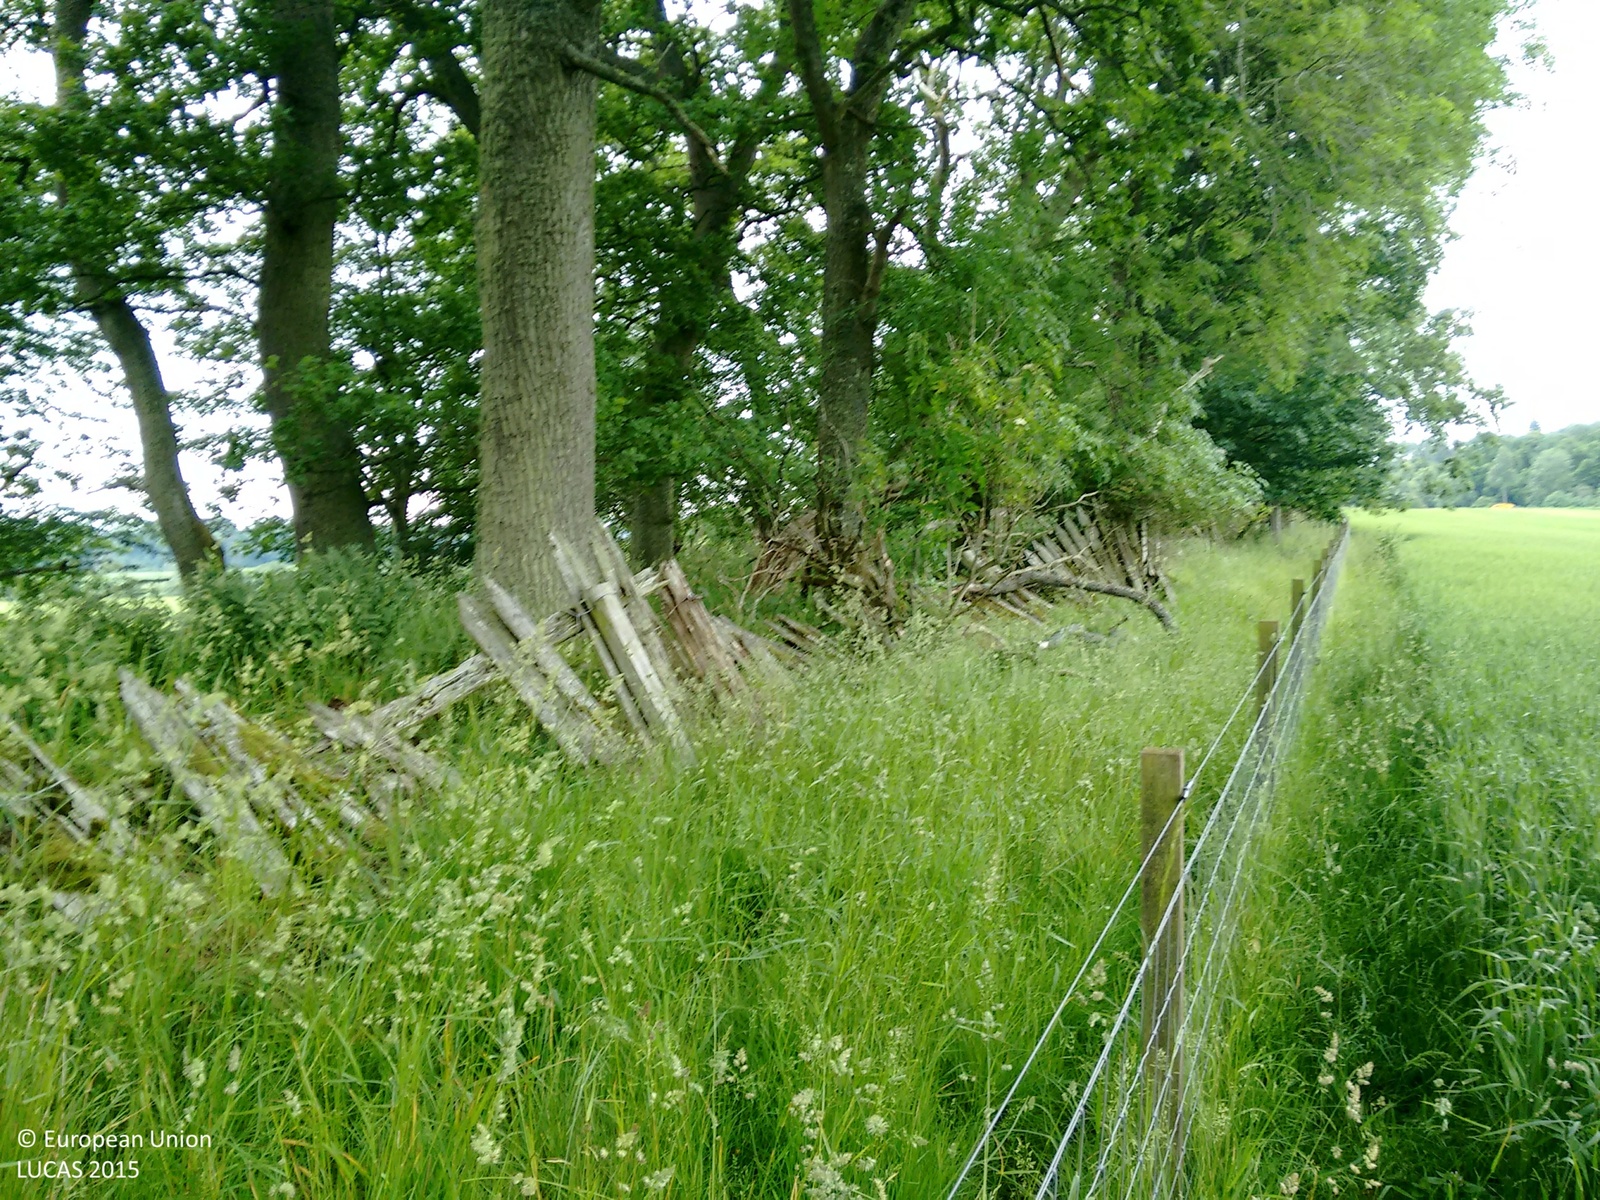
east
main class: Woodland
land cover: Broadleaved woodland
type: mesophytic deciduous forest
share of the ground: > 75 %
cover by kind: broadleaved forest trees 100 %
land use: Agriculture (excluding fallow land and kitchen gardens)
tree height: > 5 m
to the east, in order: Fences; Dry stone walls; Broadleaved woodland; Inland fresh running water
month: June
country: GB
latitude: 56.5338
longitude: -3.4559
